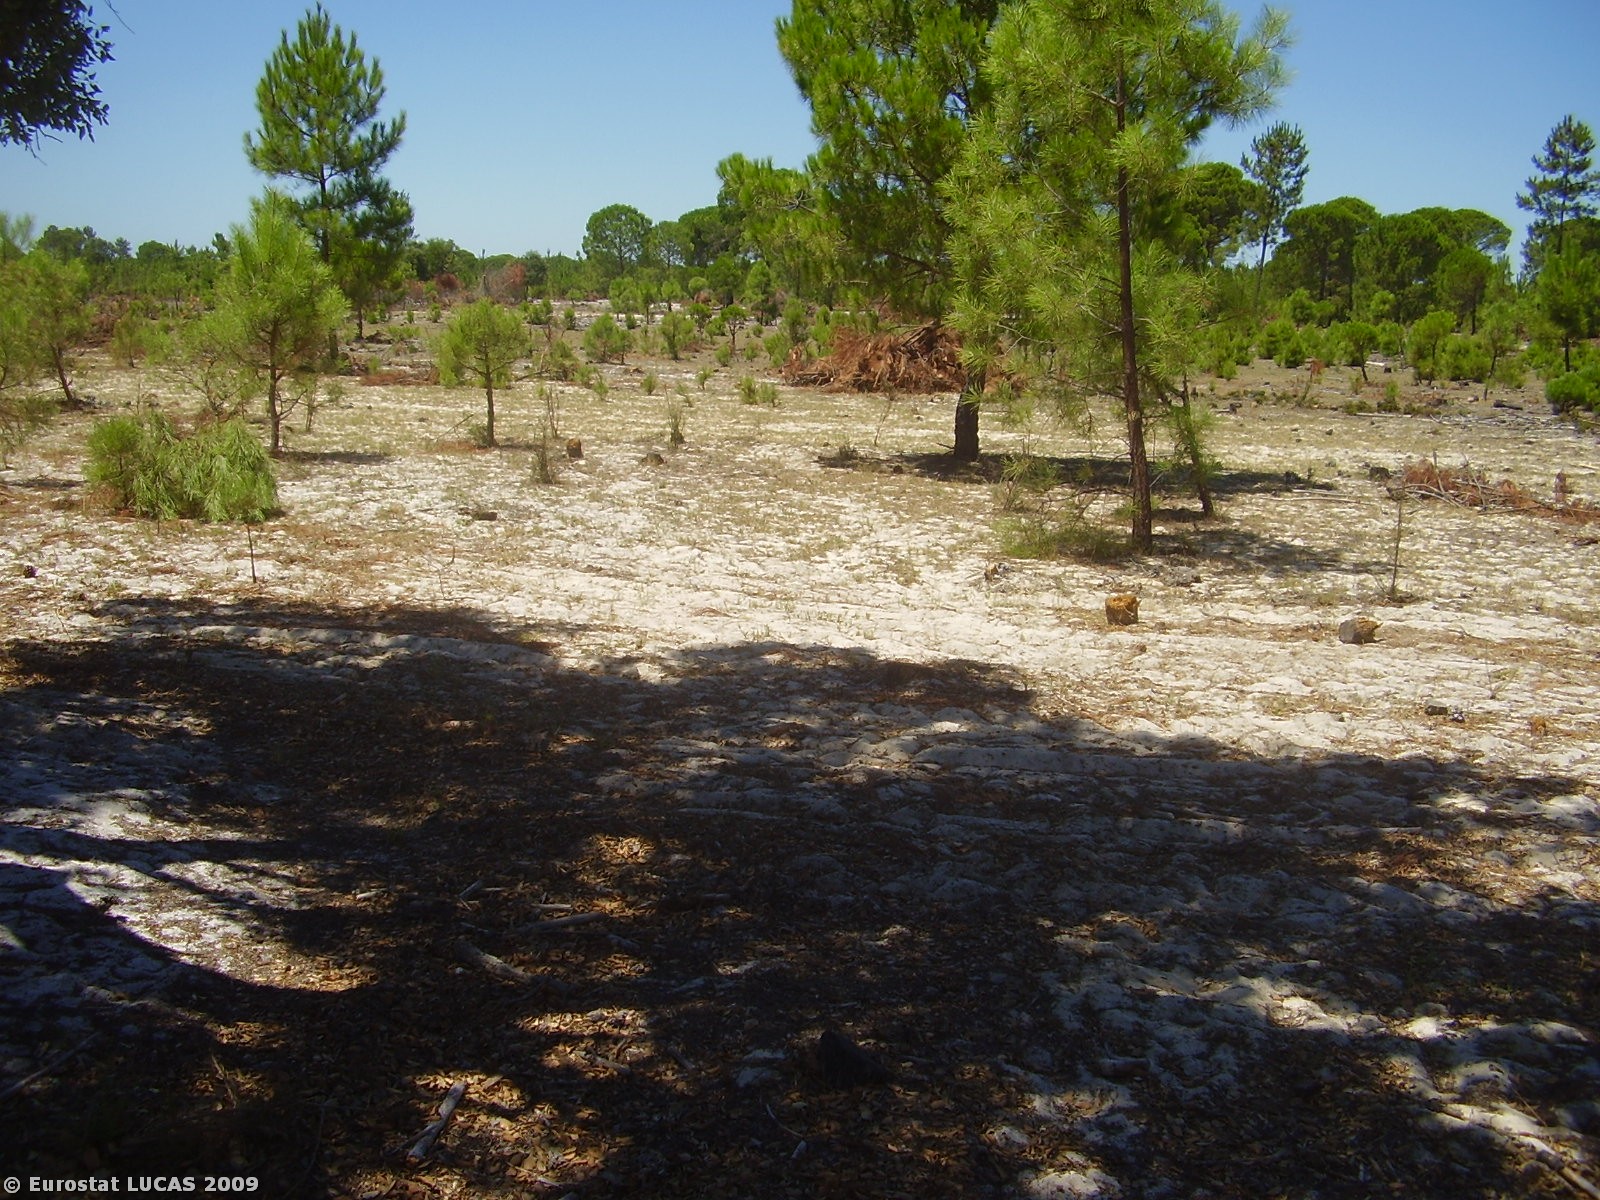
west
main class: Woodland
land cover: Coniferous woodland
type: coniferous forest of the mediterranean region
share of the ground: 10 - 25 %
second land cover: Grassland with sparse tree/shrub cover
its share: 10 - 25 %
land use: Forestry
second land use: Fallow land
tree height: > 5 m
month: July
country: PT
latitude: 38.1922
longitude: -8.4161
